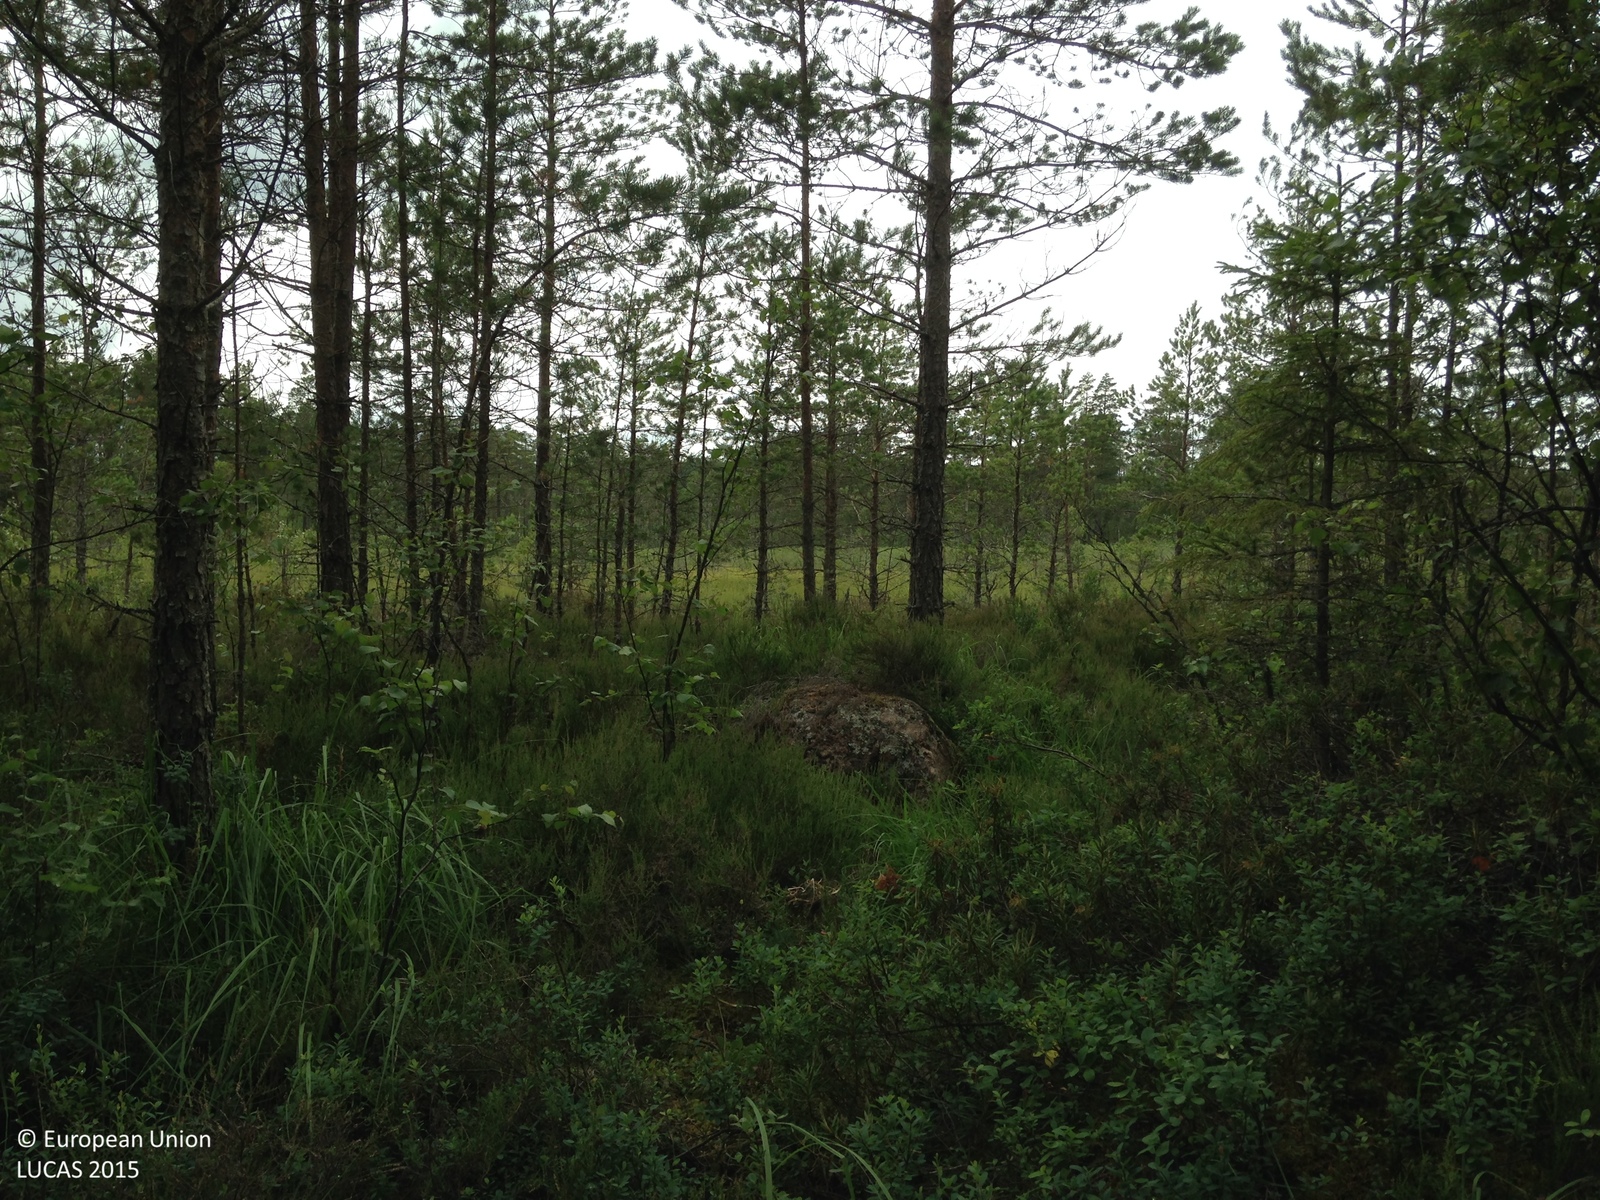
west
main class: Woodland
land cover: Pine dominated coniferous woodland
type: boreal forest
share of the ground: 50 - 75 %
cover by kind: coniferous forest trees 55 %, shrubs 25 %, herbaceous plants 10 %, broadleaved forest trees 5 %, lichens and mosses 5 %
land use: Semi-natural and natural areas not in use
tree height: < 5 m
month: July
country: SE
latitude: 58.9889
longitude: 14.5690
